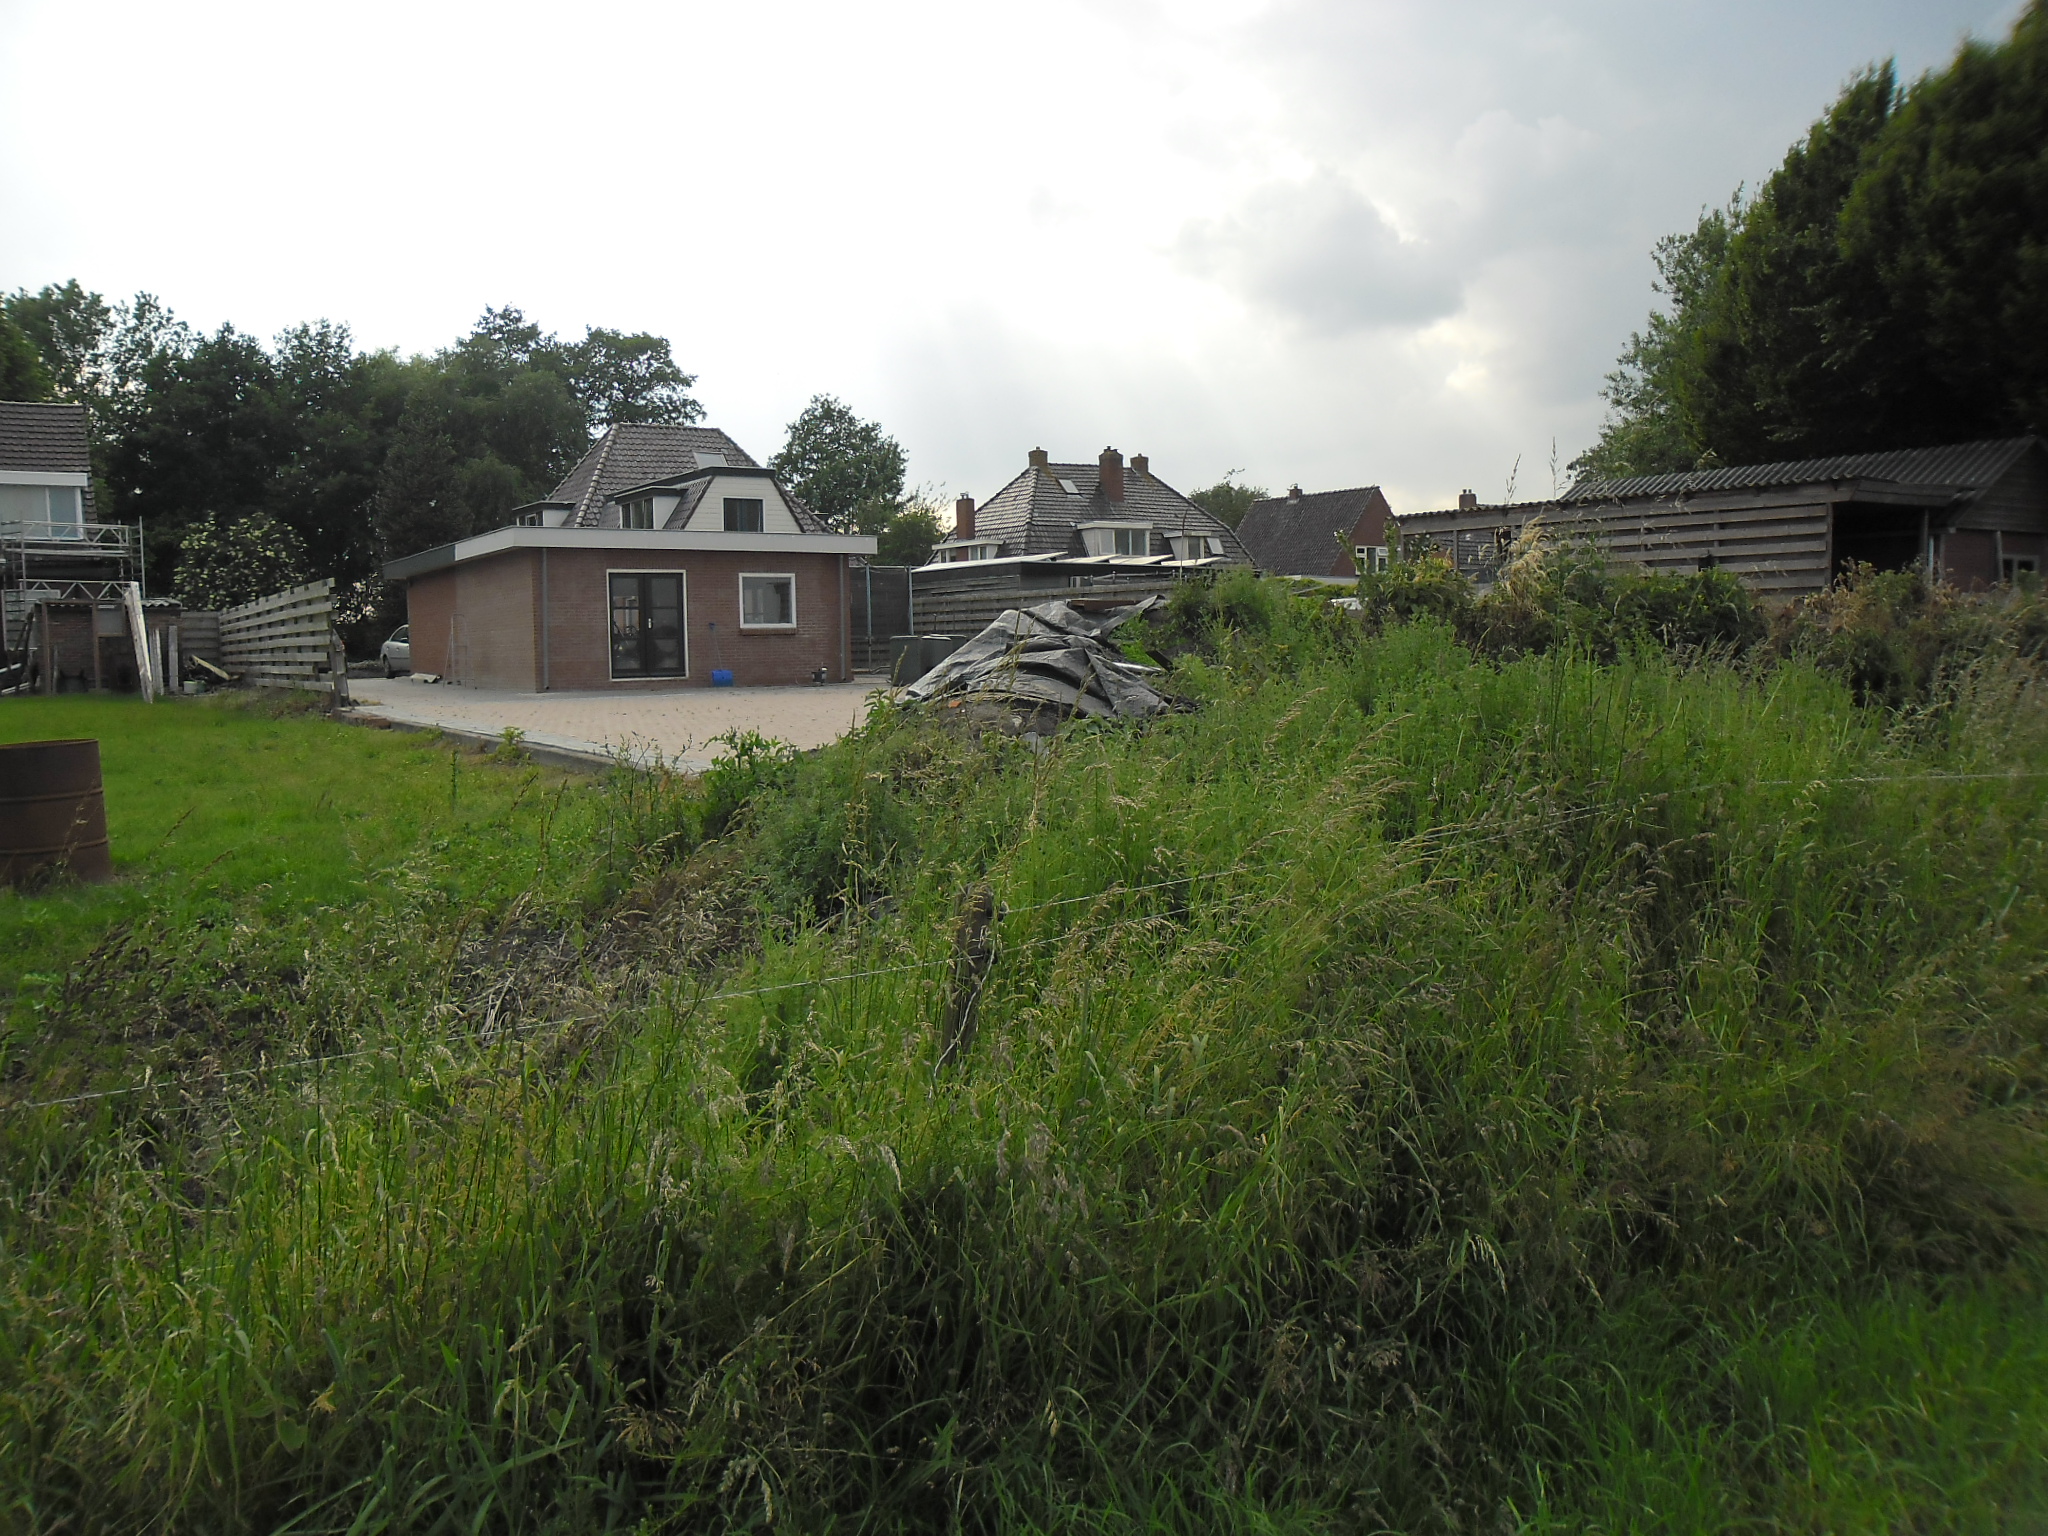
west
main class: Grassland
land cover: Grassland without tree/shrub cover
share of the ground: > 75 %
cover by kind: herbaceous plants 100 %
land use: Agriculture (excluding fallow land and kitchen gardens)
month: June
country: NL
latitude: 53.1770
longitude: 6.6936
